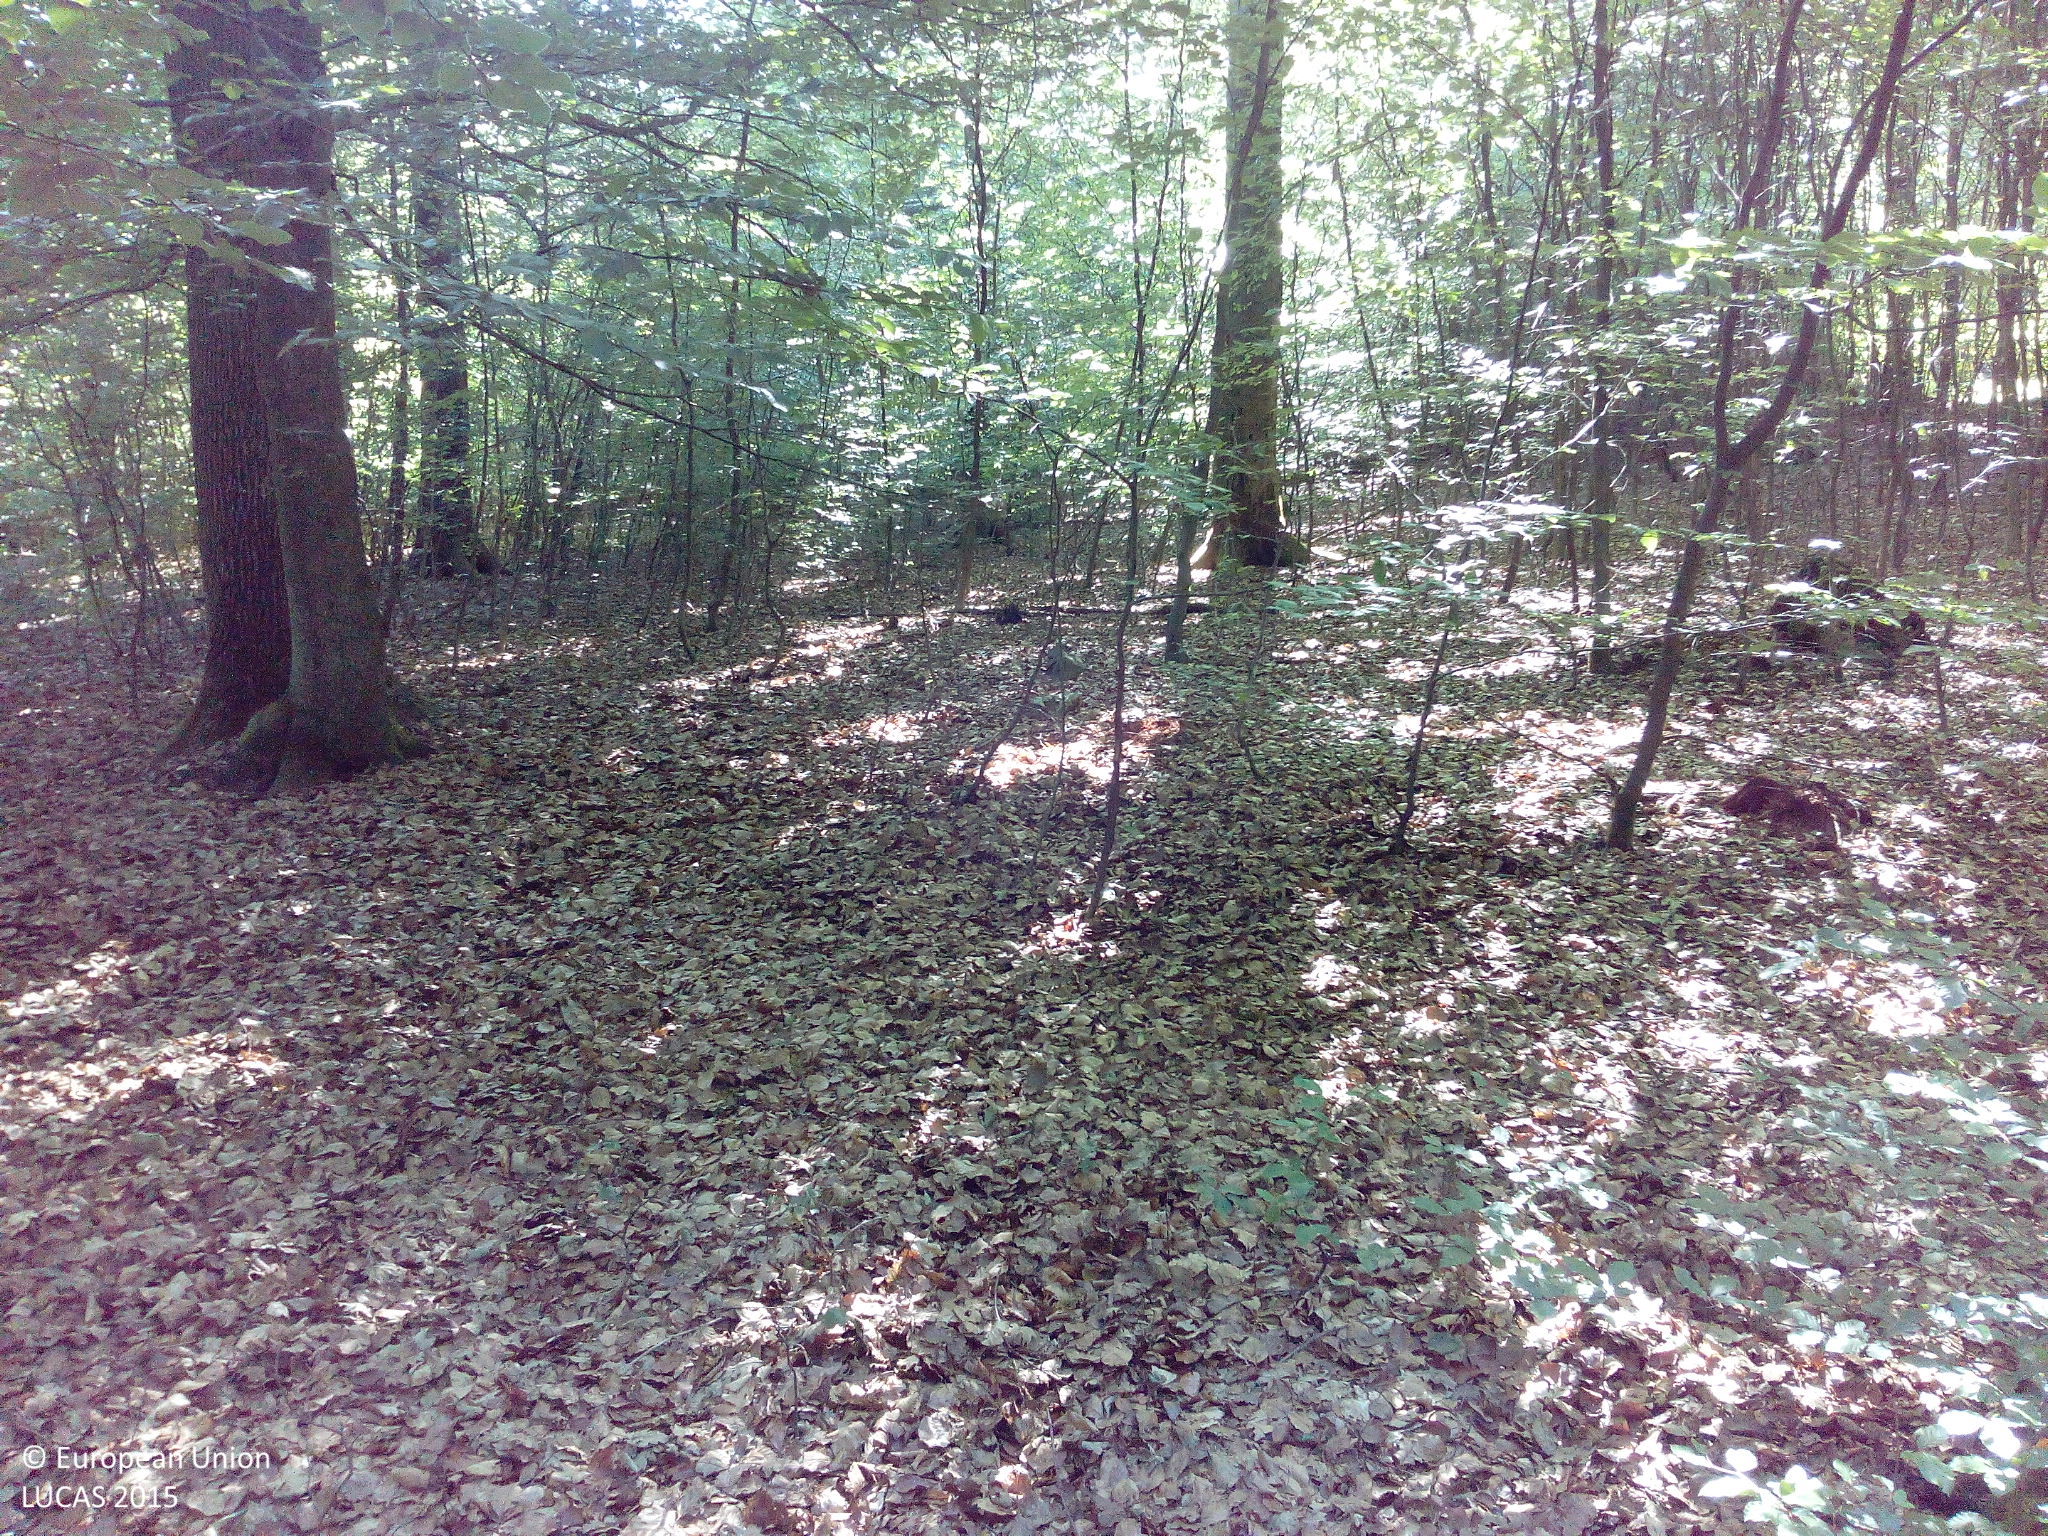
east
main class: Woodland
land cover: Broadleaved woodland
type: mesophytic deciduous forest
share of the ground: > 75 %
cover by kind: broadleaved forest trees 95 %, unconsolidated bare surface 5 %
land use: Forestry
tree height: > 5 m
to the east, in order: Broadleaved woodland; Spruce dominated mixed woodland; Spruce dominated coniferous woodland; Spruce dominated mixed woodland; Grass margins; Paved roads, cycling and walking lanes; Ditches and canals; Grass margins; Broadleaved woodland
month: July
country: DE
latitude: 50.0773
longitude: 8.0301
